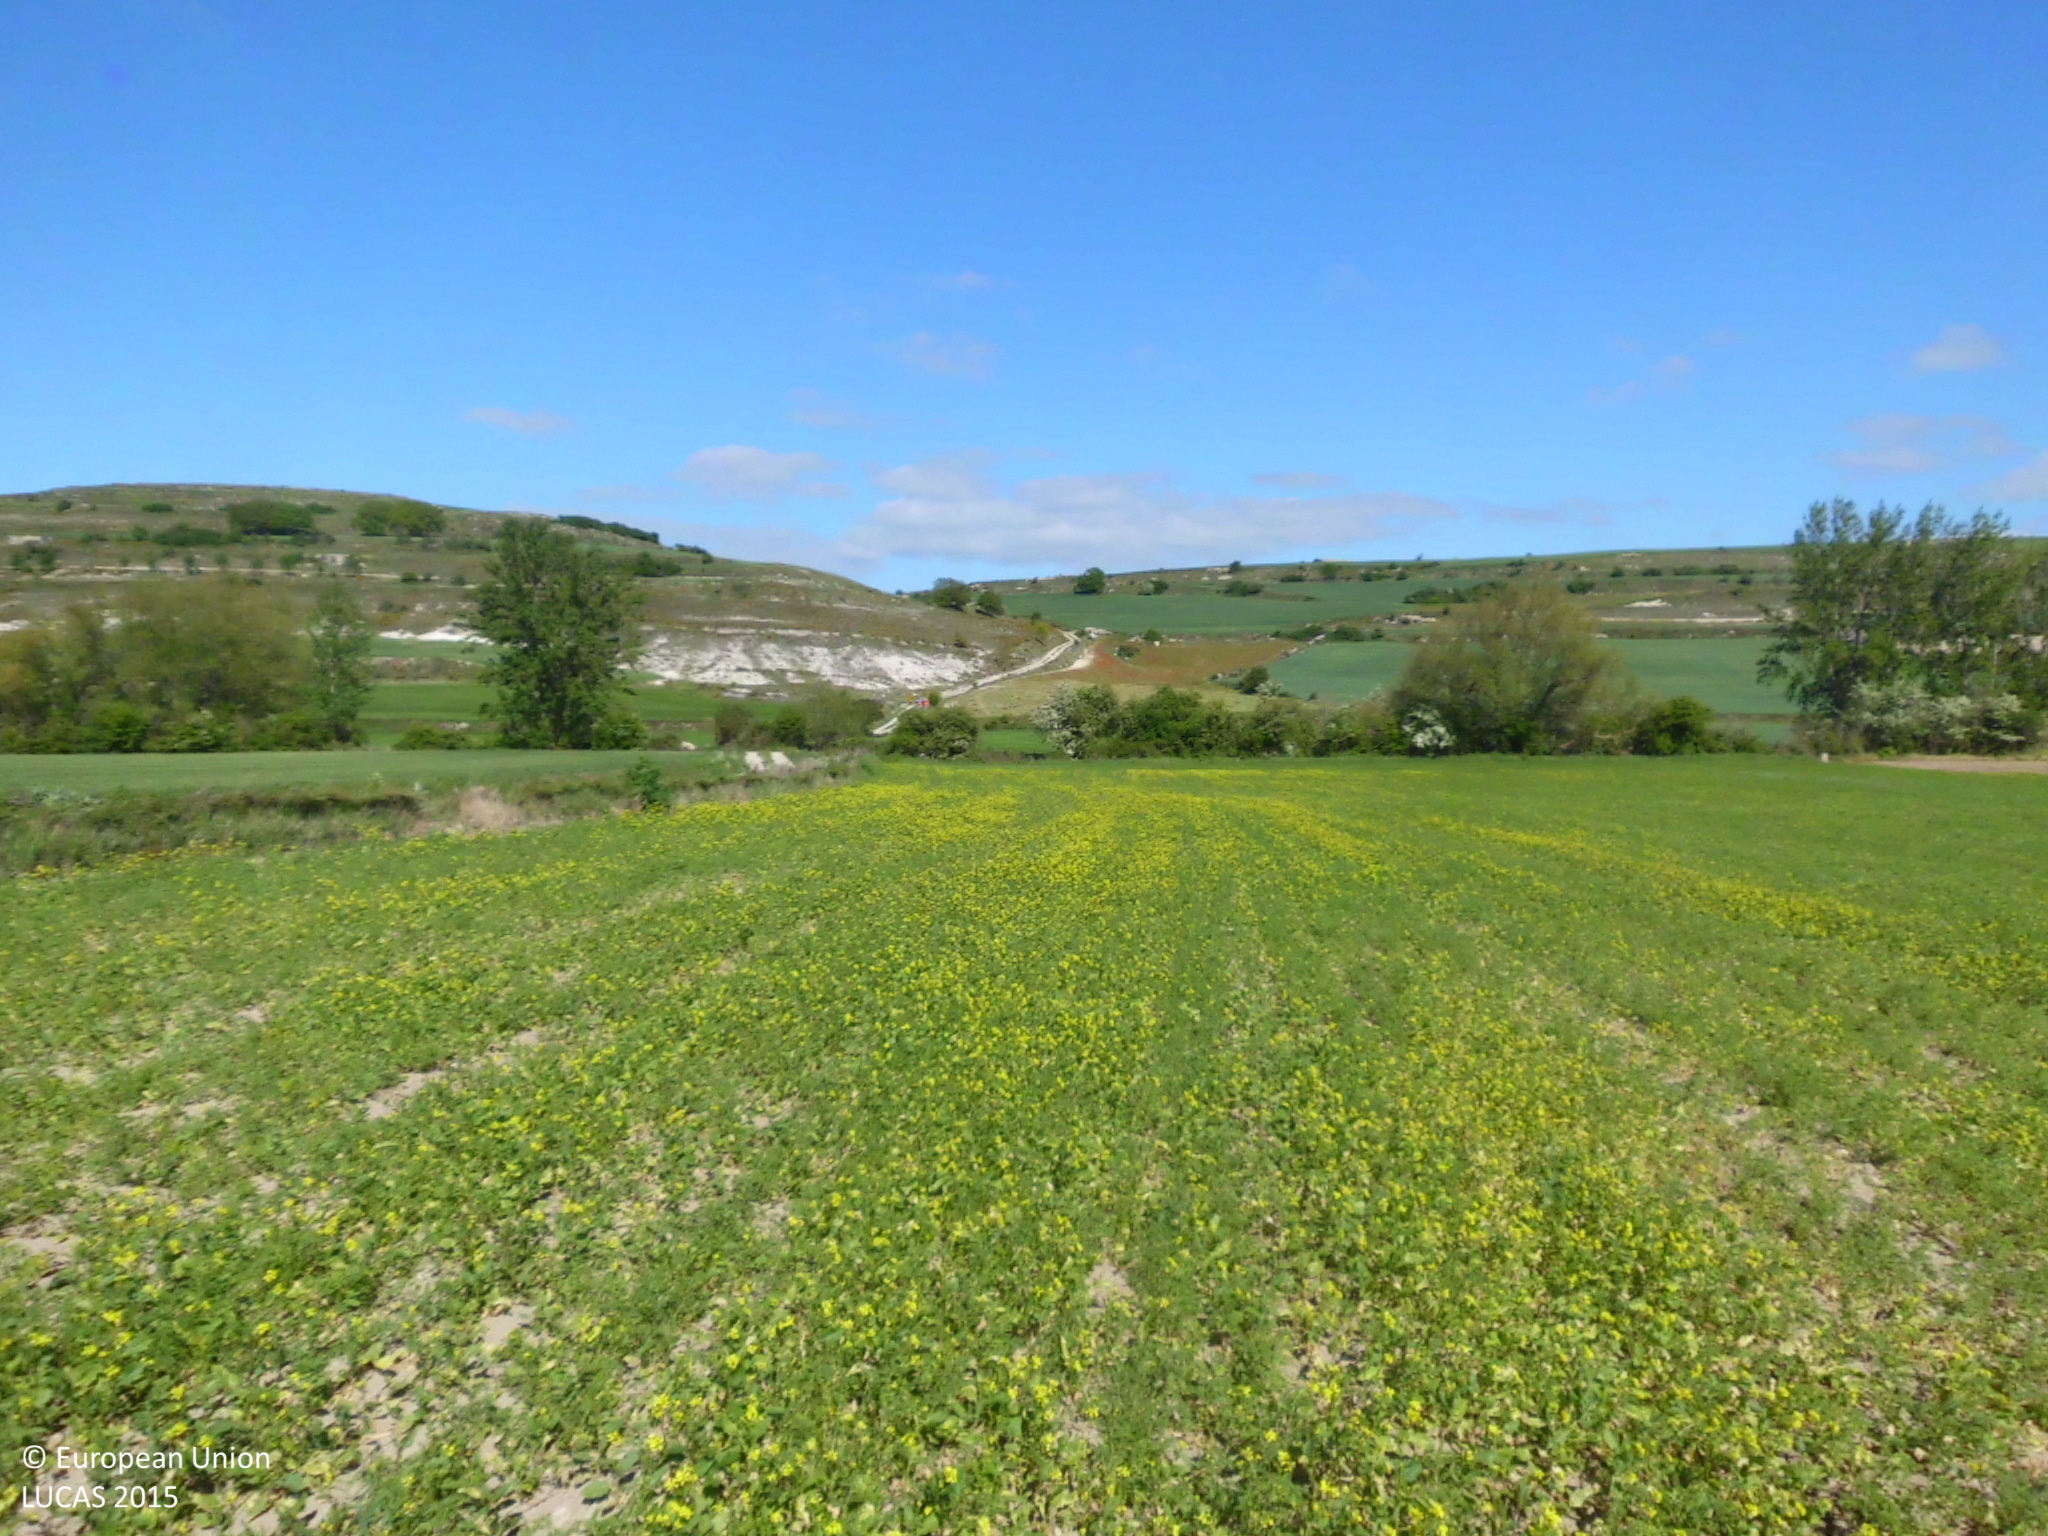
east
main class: Cropland
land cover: Lucerne
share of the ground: > 75 %
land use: Agriculture (excluding fallow land and kitchen gardens)
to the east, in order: Lucerne; Grass margins; Groves; Rivers and streams; Common wheat; Grass margins; Tracks; Common wheat; Tracks; Grass margins; Lucerne
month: May
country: ES
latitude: 42.4533
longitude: -3.9394
